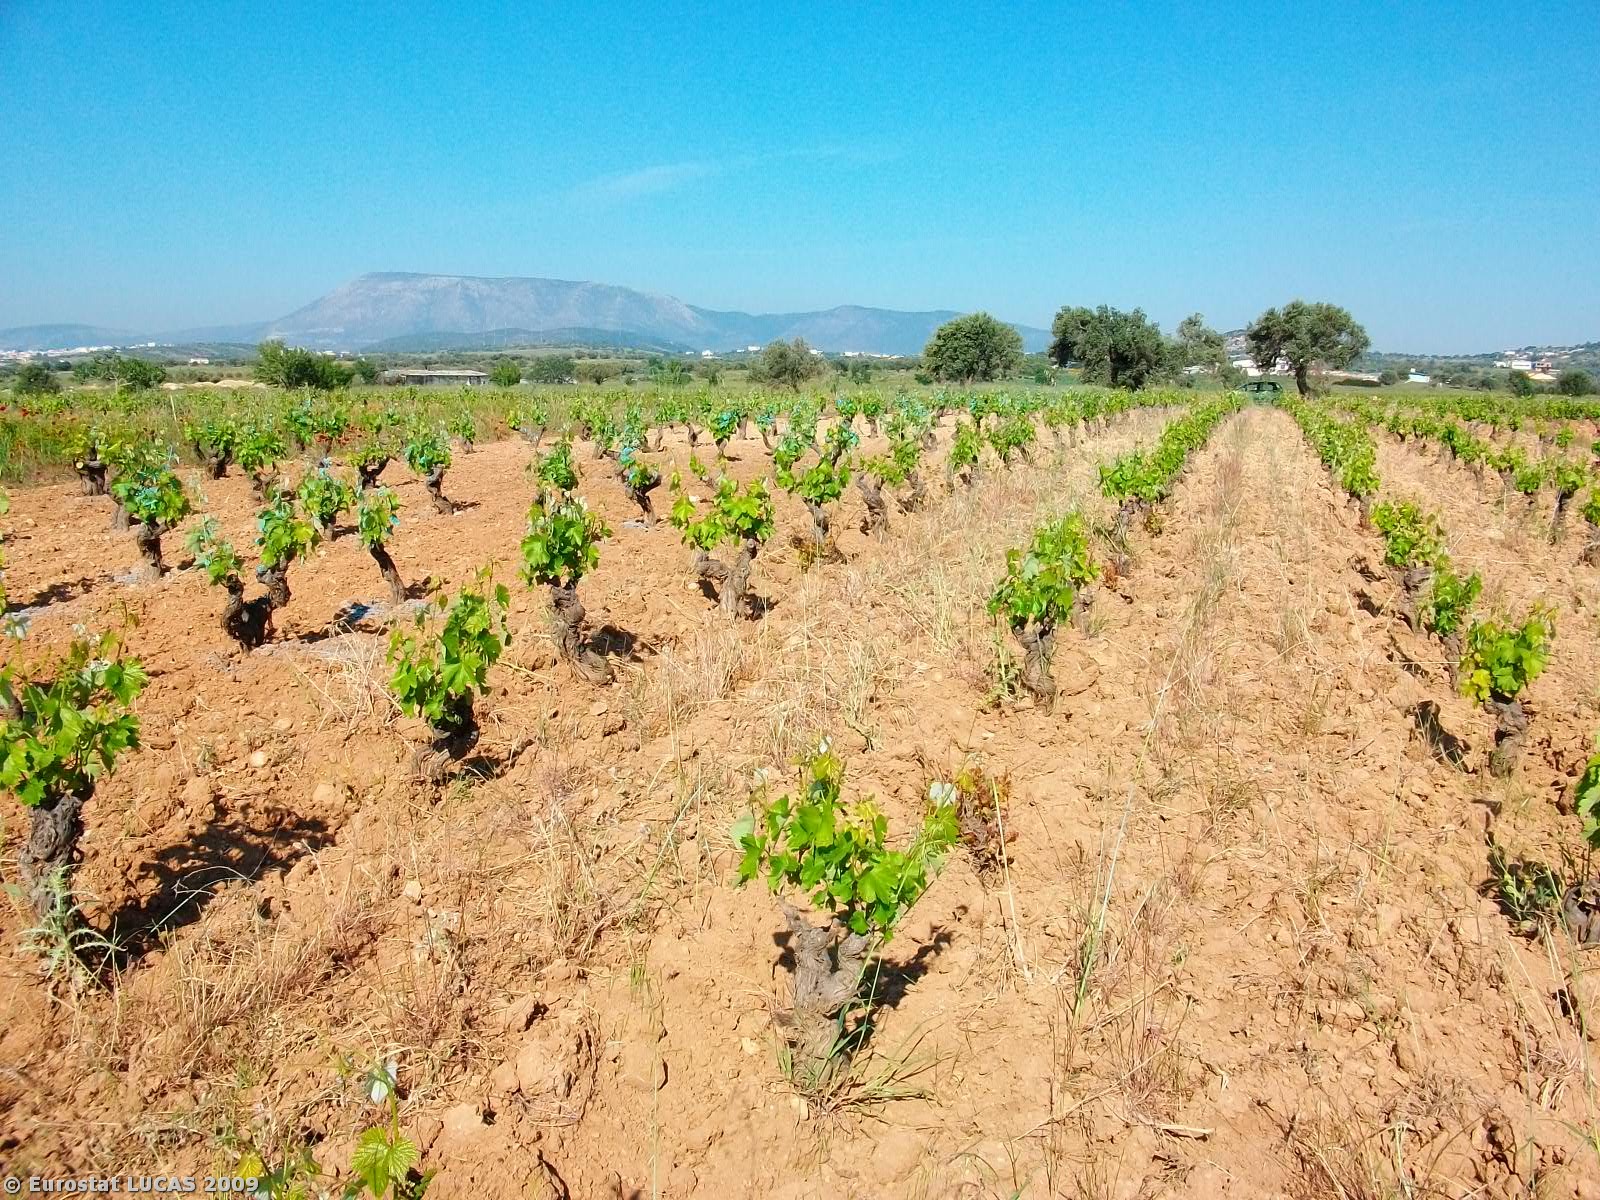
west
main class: Cropland
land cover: Vineyards
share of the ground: 25 - 50 %
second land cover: Bare land
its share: > 75 %
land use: Agriculture (excluding fallow land and kitchen gardens)
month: May
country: GR
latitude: 37.9808
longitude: 23.9523
